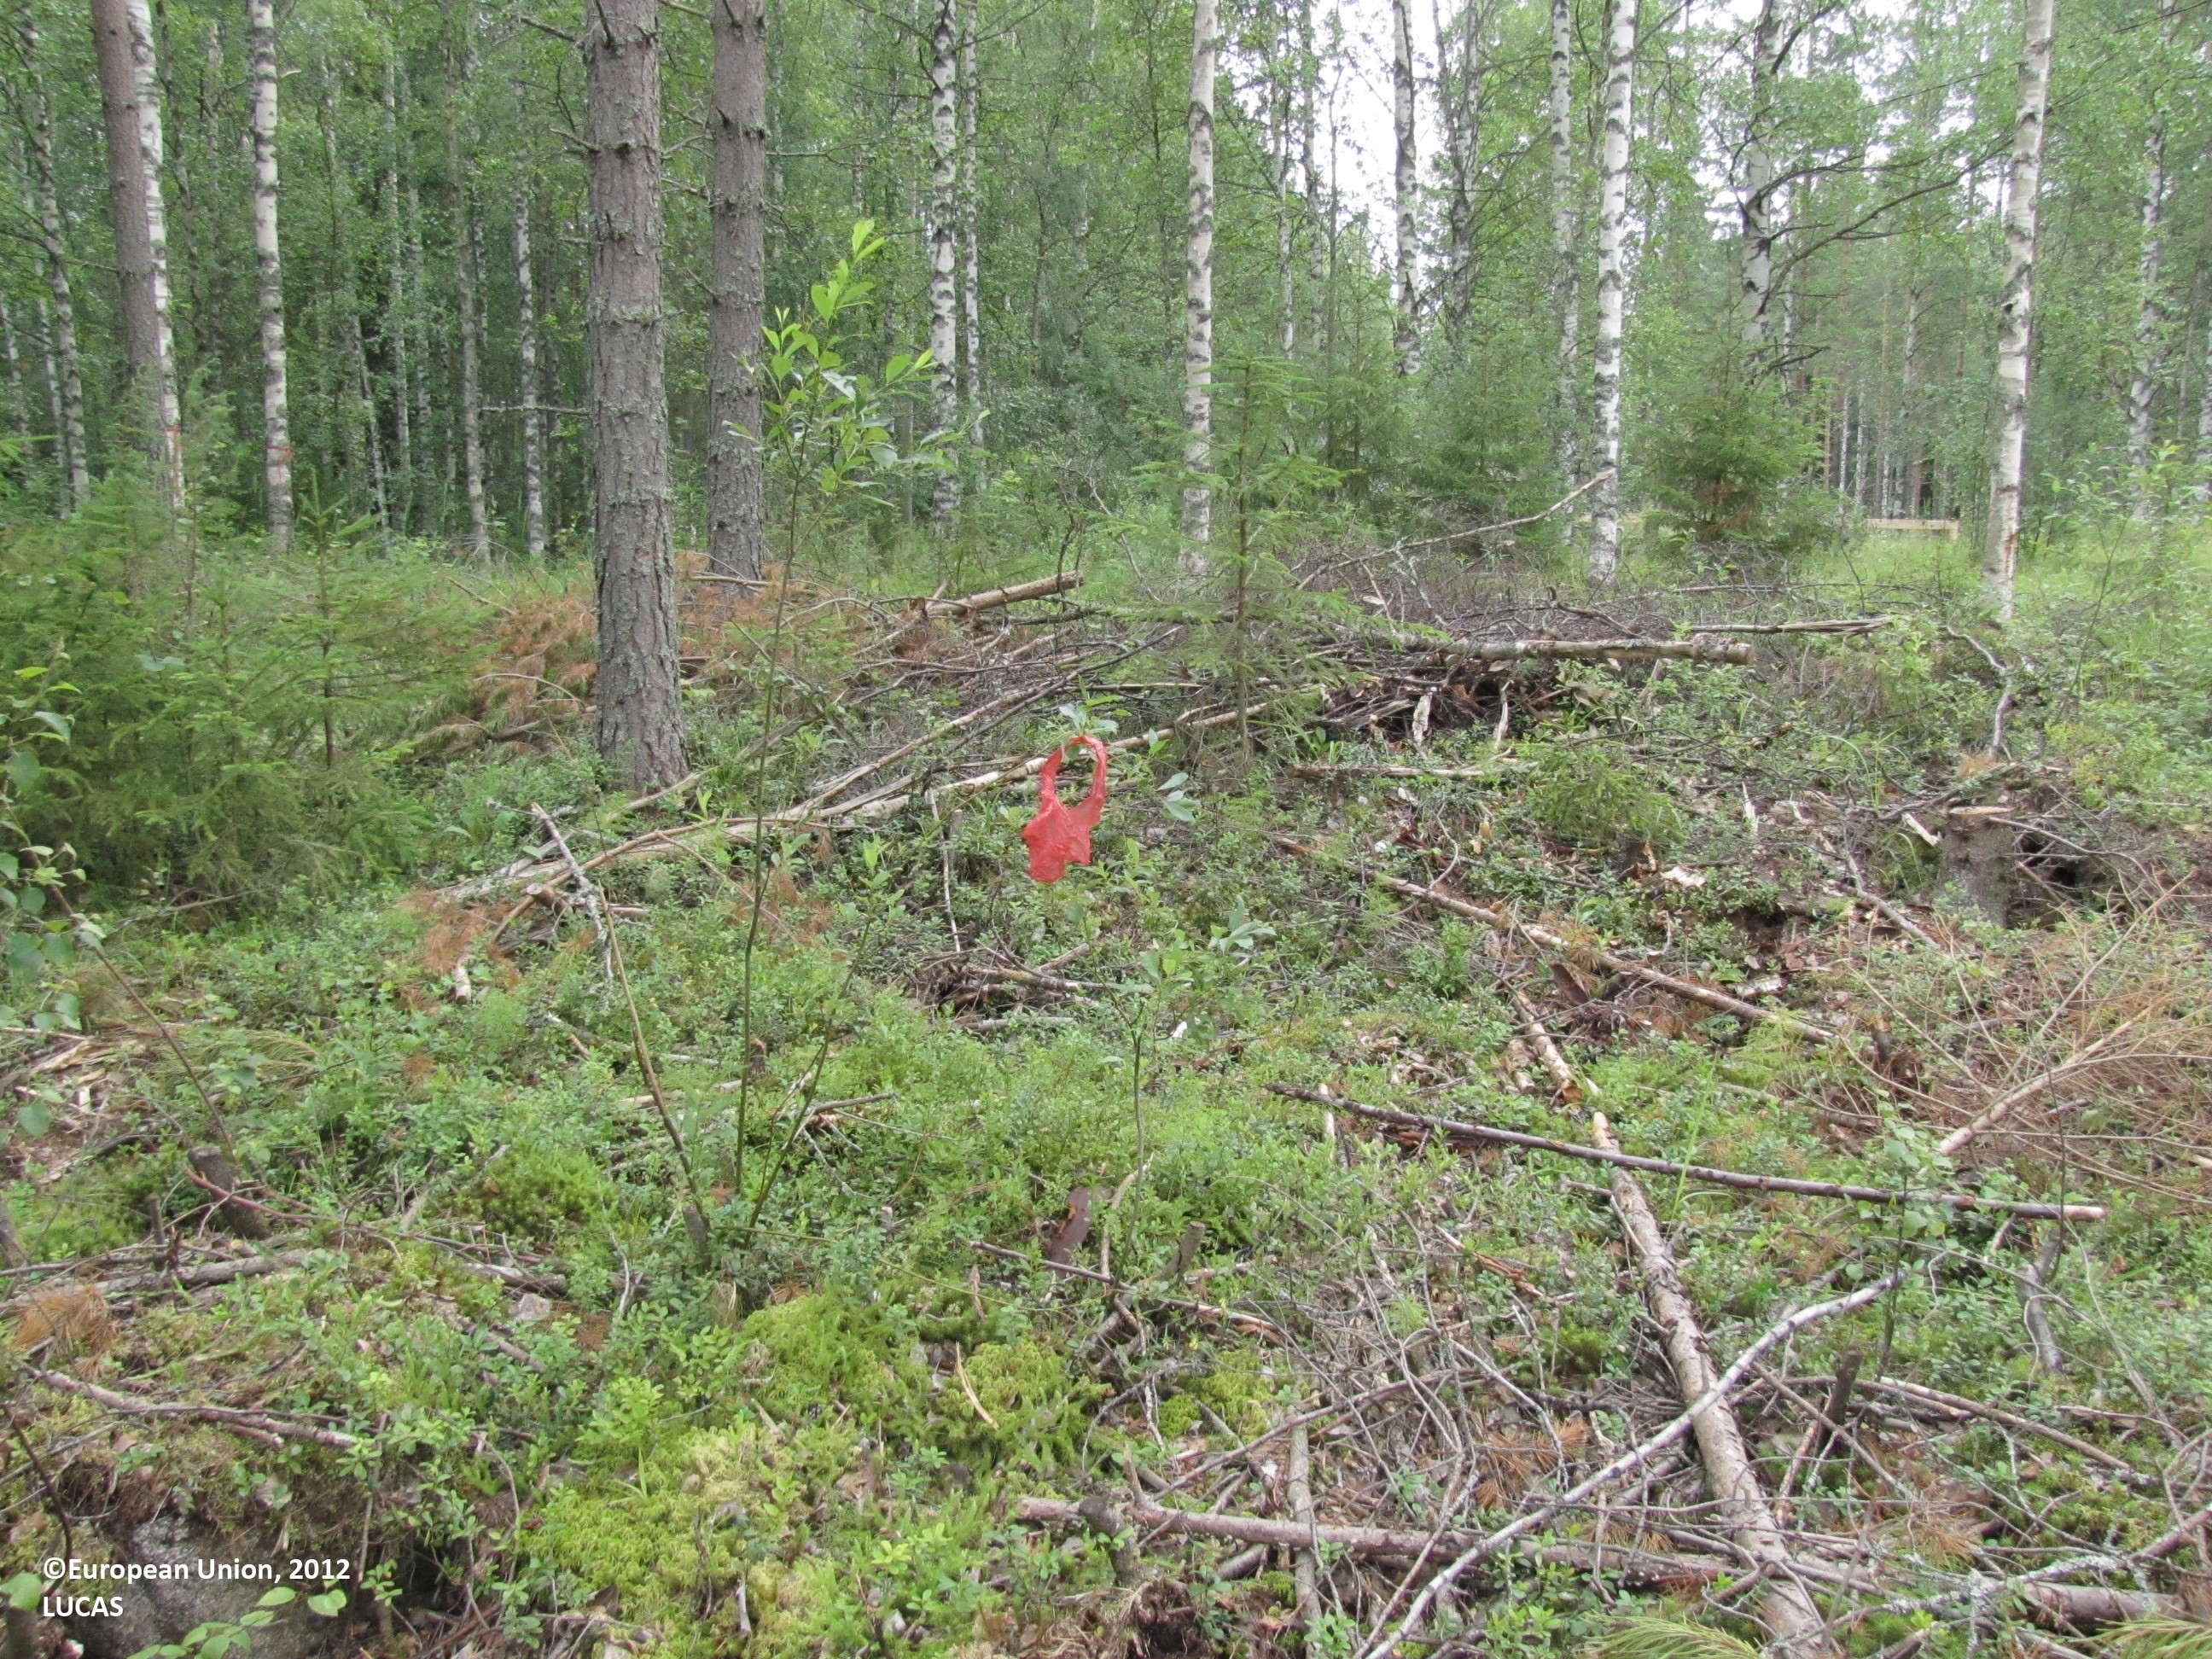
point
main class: Woodland
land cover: Pine dominated coniferous woodland
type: boreal forest
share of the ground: 50 - 75 %
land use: Forestry
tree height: > 5 m
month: July
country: FI
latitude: 62.6347
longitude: 23.3868
